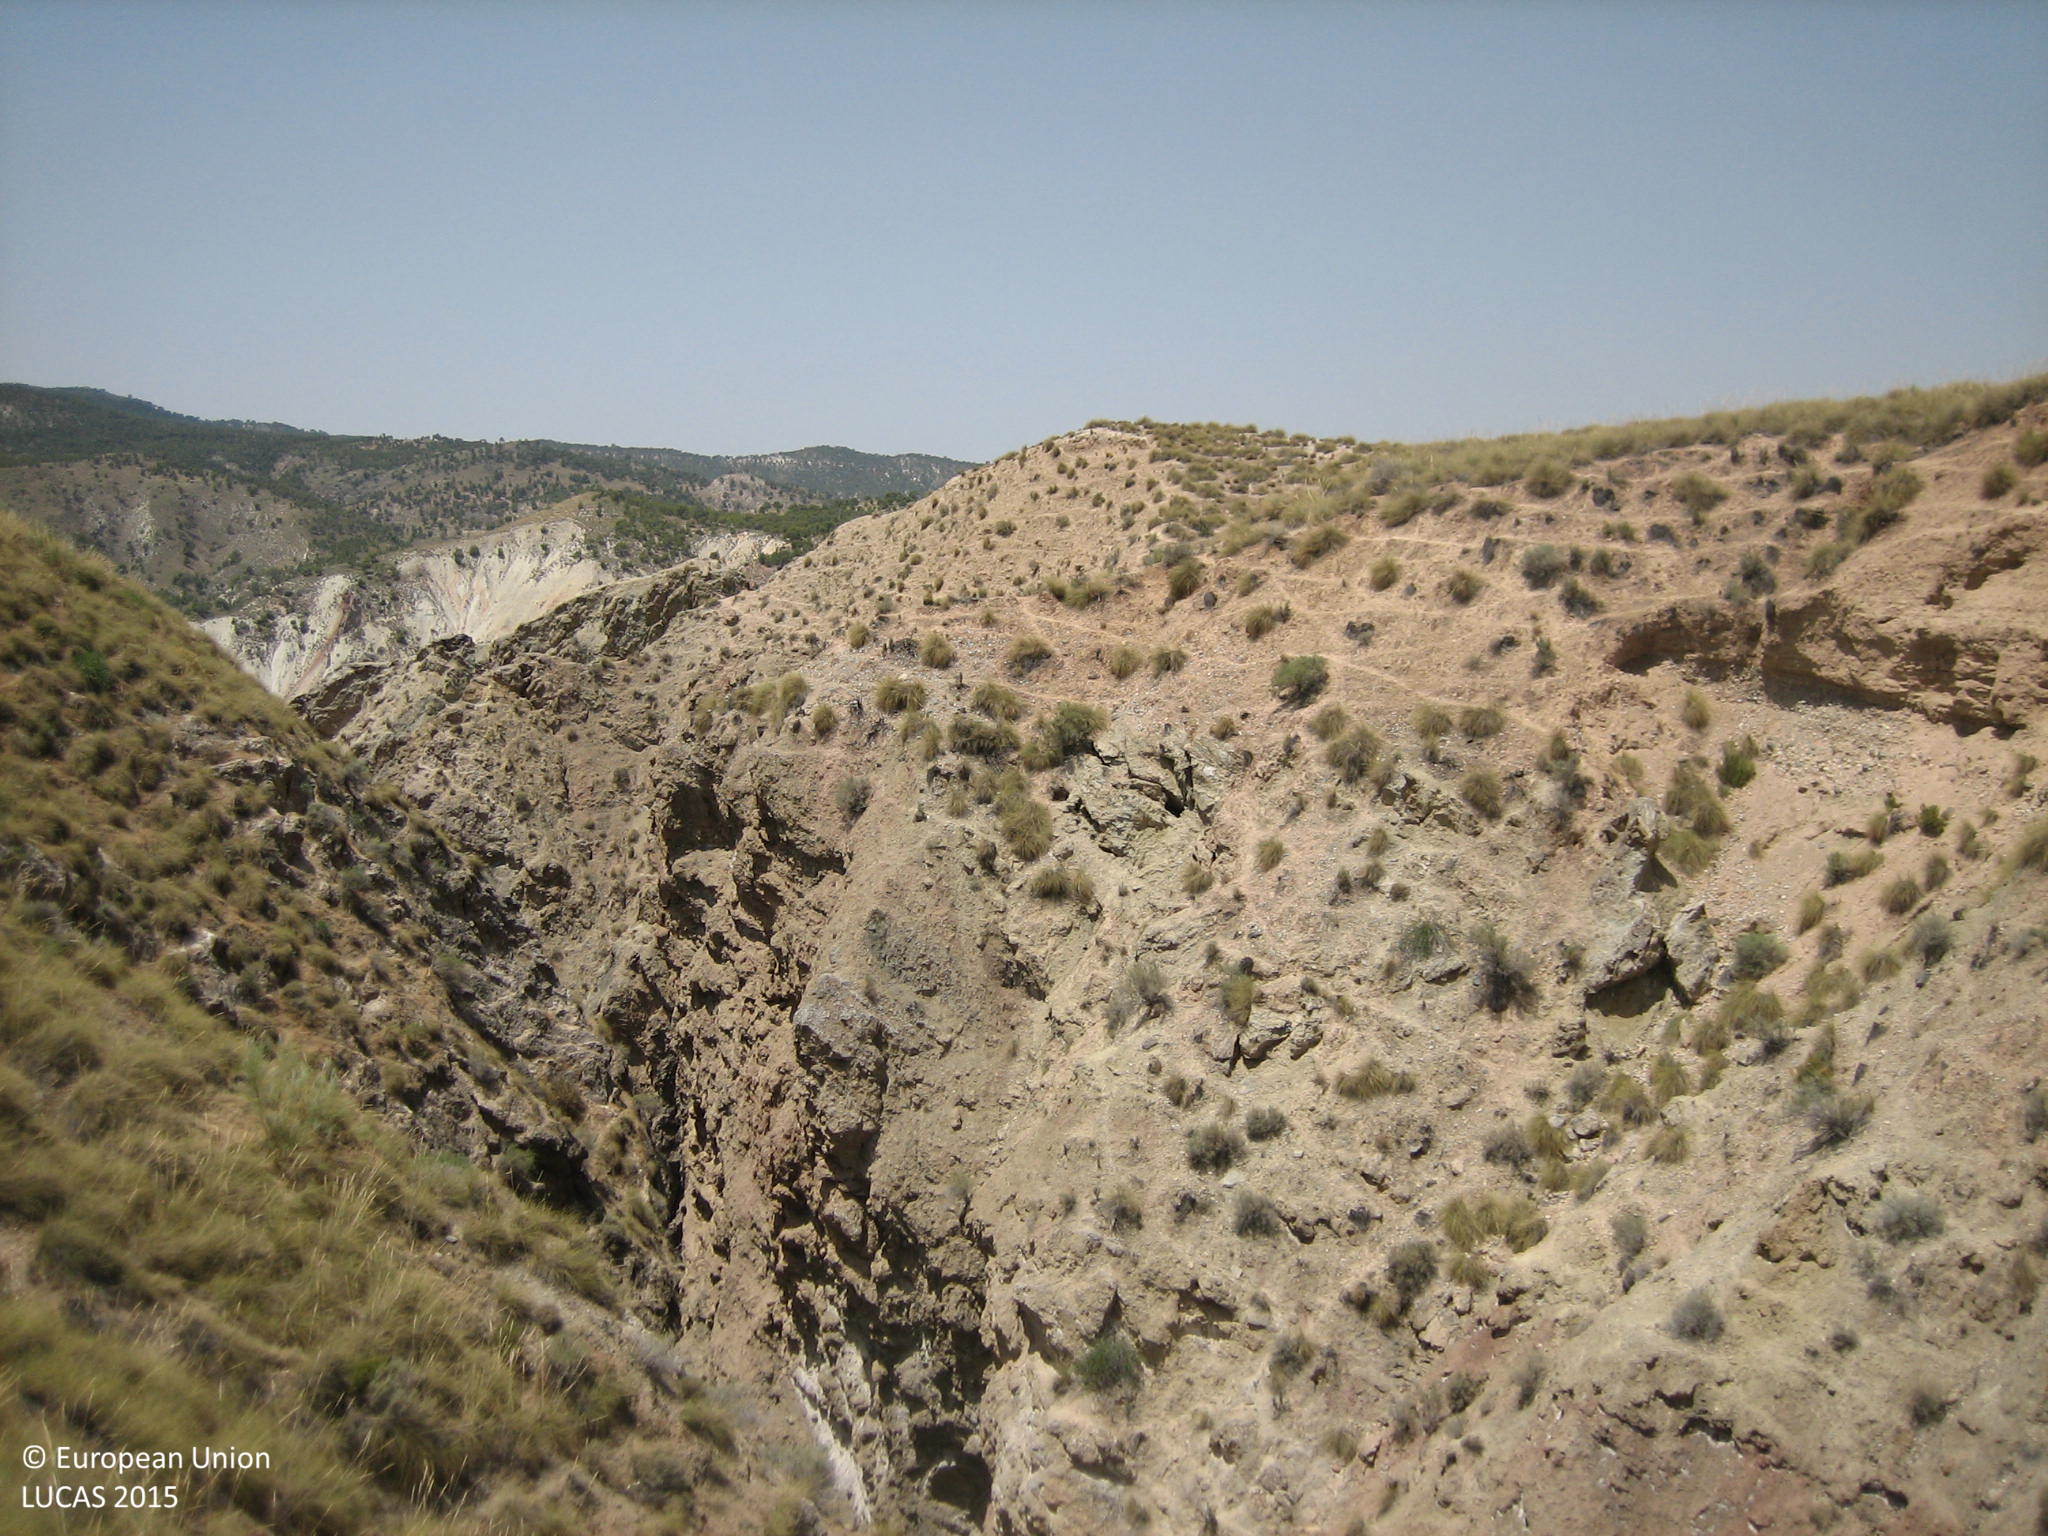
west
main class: Grassland
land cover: Grassland without tree/shrub cover
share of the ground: > 75 %
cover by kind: herbaceous plants 80 %, consolidated bare surface 20 %
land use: Agriculture (excluding fallow land and kitchen gardens)
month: July
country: ES
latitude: 37.6917
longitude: -3.0224
